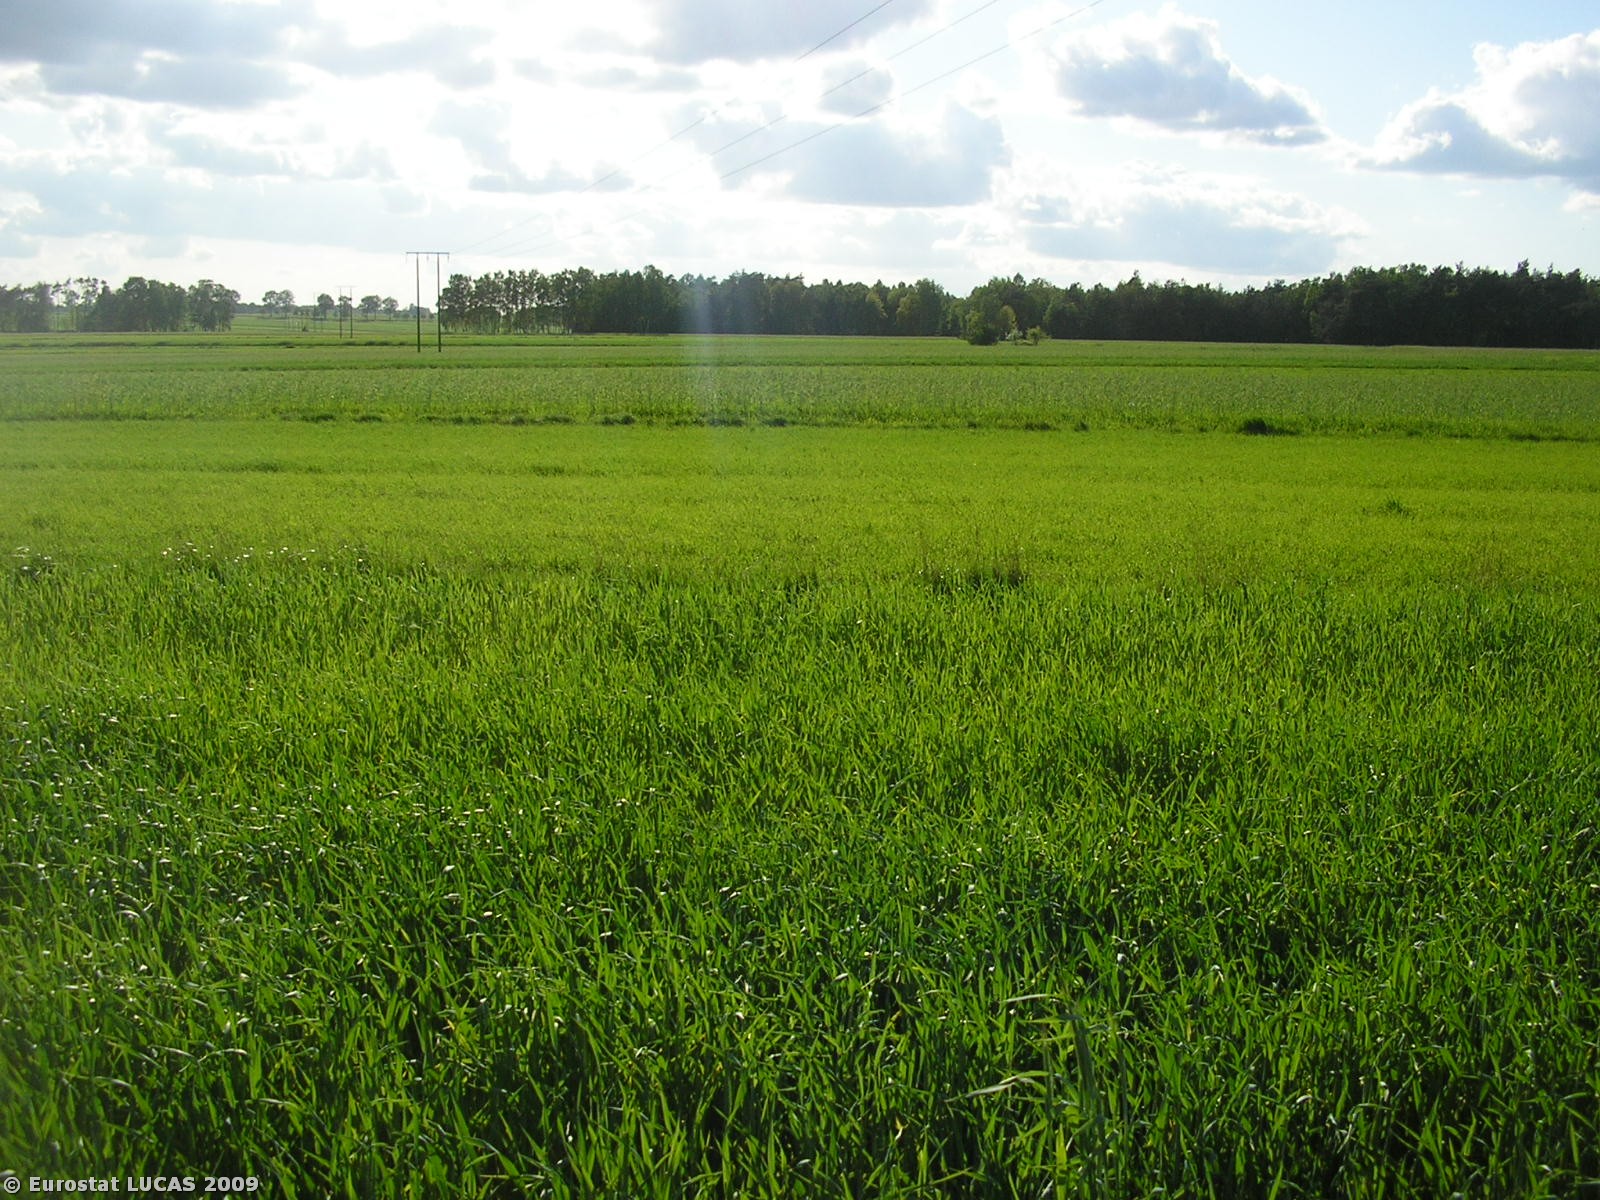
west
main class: Cropland
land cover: Triticale
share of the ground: > 75 %
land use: Agriculture (excluding fallow land and kitchen gardens)
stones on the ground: < 10 %
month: May
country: PL
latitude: 51.9137
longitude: 20.0499
